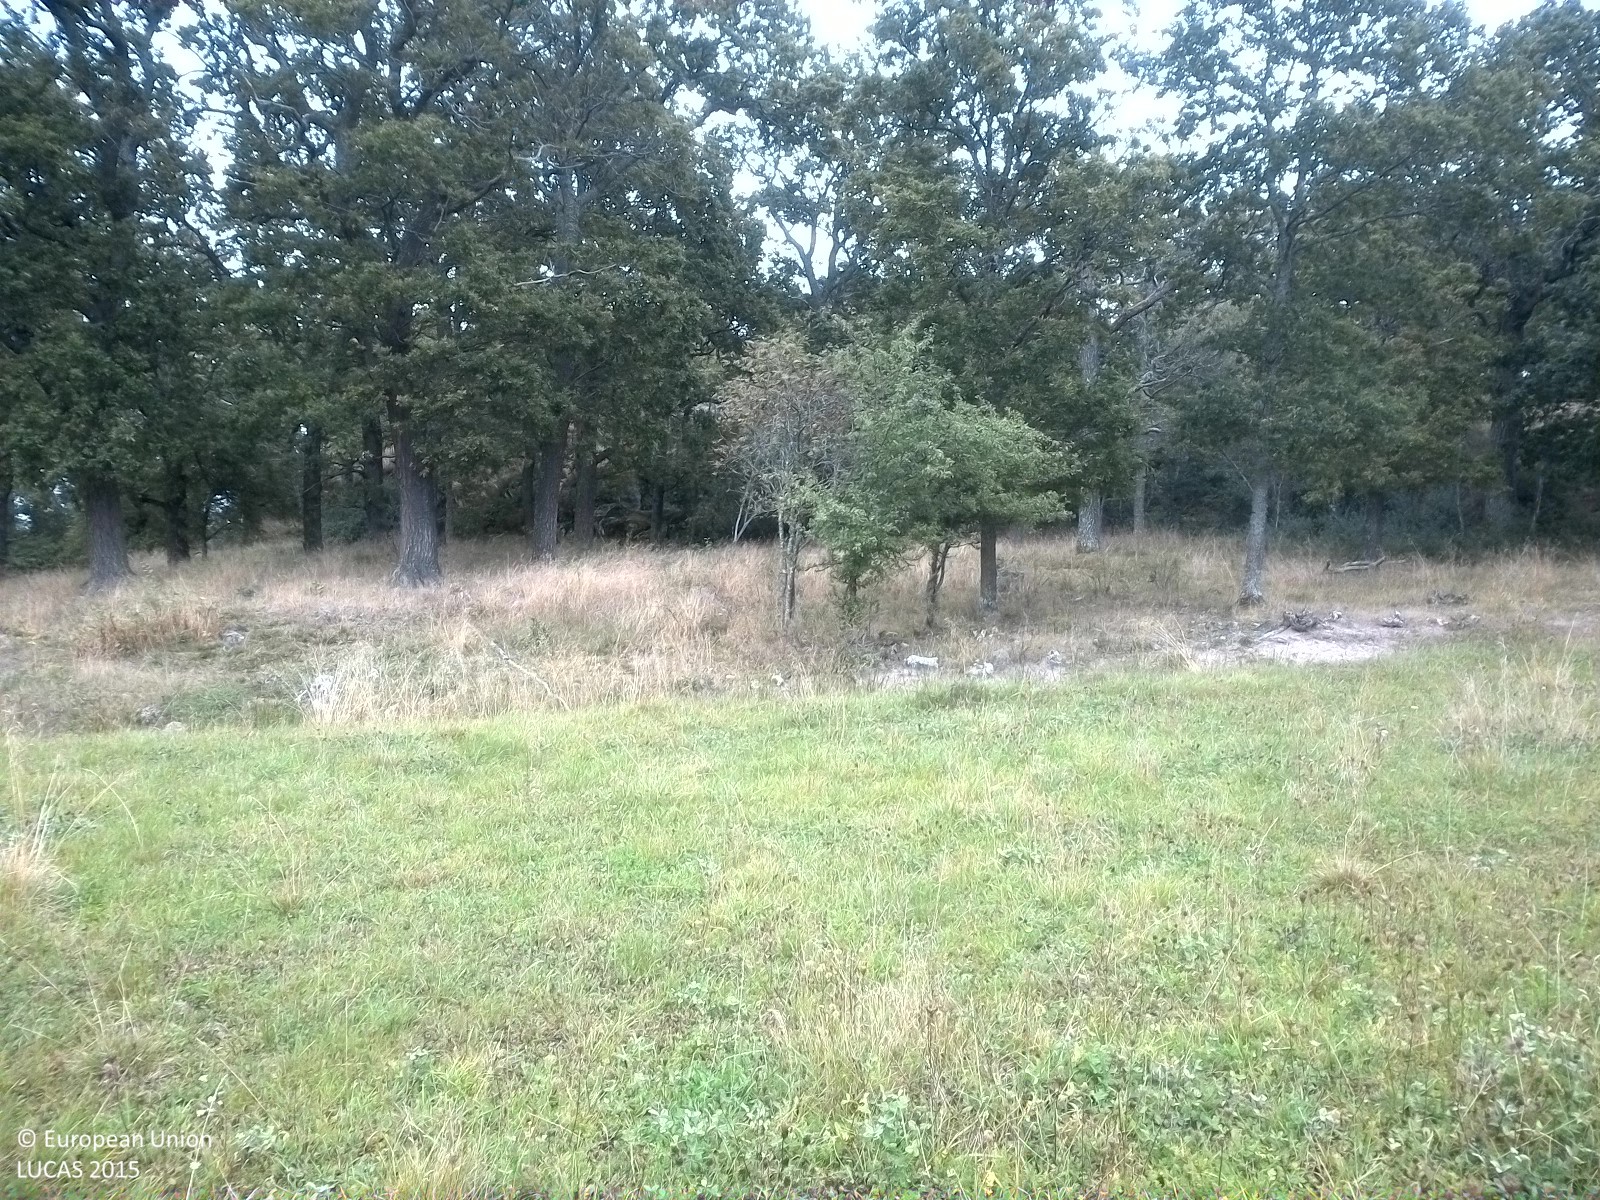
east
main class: Grassland
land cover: Grassland without tree/shrub cover
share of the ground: > 75 %
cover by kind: herbaceous plants 100 %
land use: Agriculture (excluding fallow land and kitchen gardens)
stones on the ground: < 10 %
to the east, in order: Grassland without tree/shrub cover; Ditches and canals; Broadleaved woodland; Rocks and stones; Broadleaved woodland; Fences; Ditches and canals; Other bare soil; Electric lines; Other bare soil
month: September
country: SE
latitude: 58.6111
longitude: 16.3472
